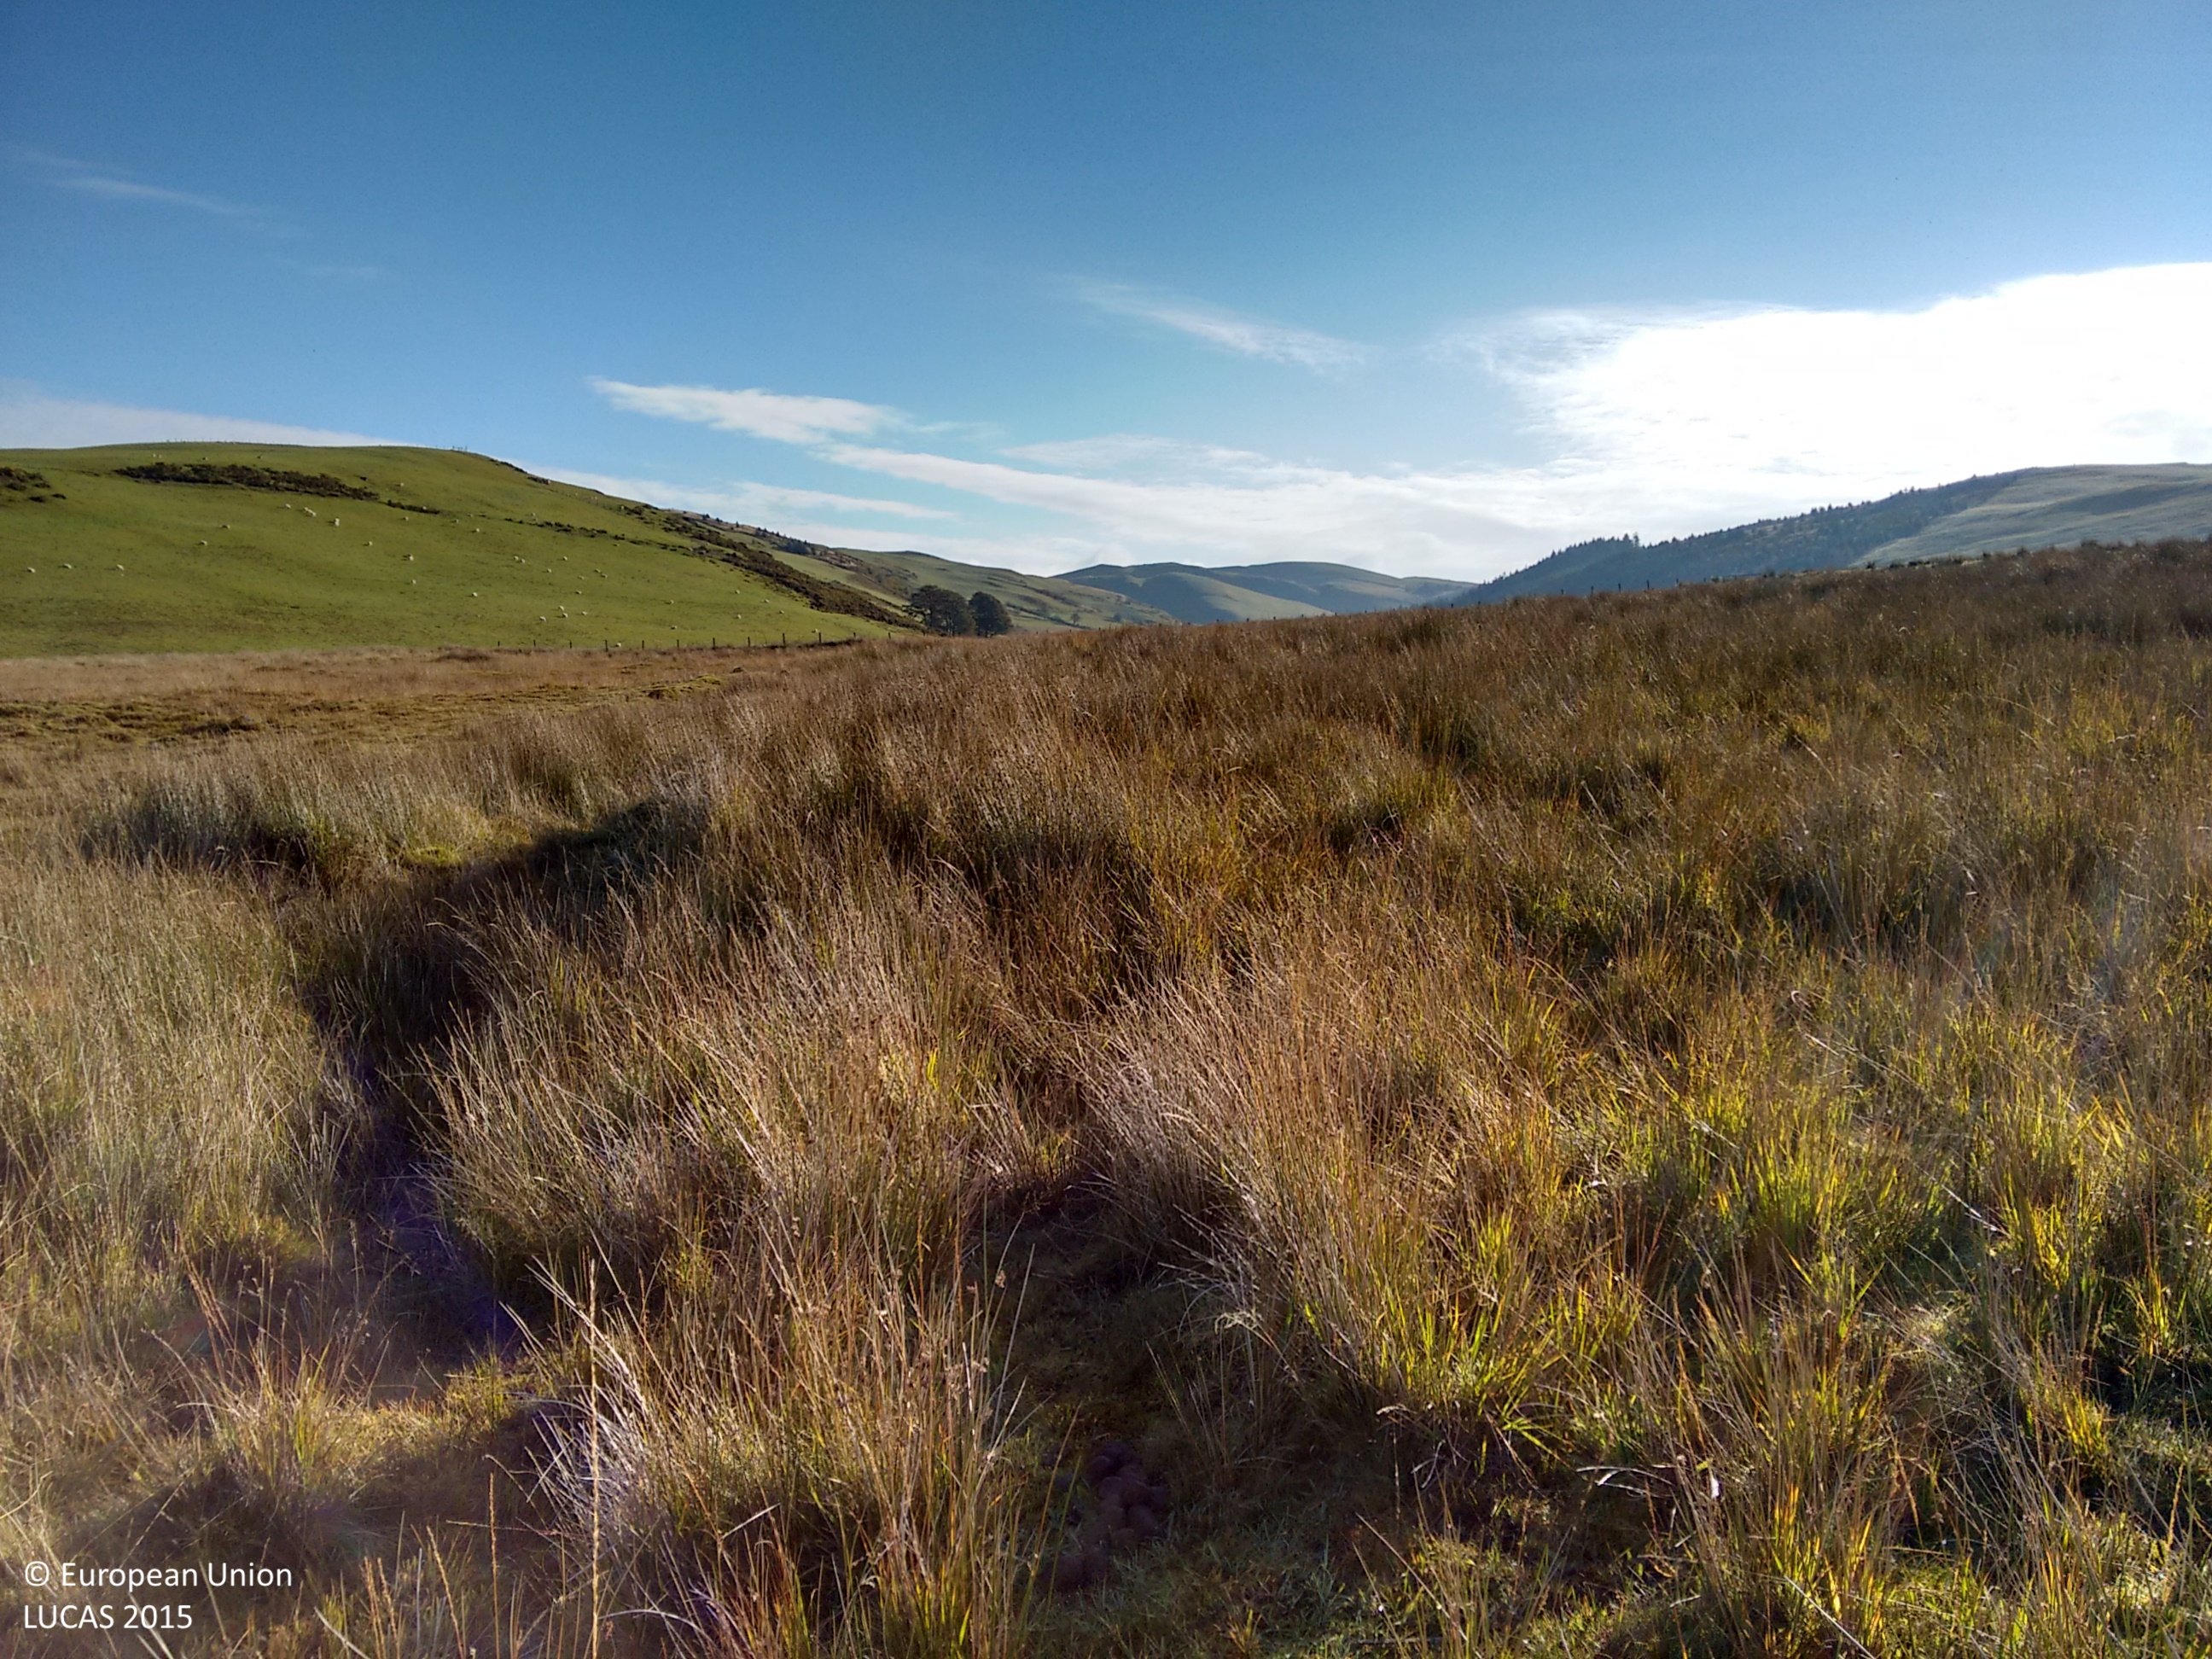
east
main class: Grassland
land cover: Grassland without tree/shrub cover
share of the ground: > 75 %
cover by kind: herbaceous plants 100 %
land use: Agriculture (excluding fallow land and kitchen gardens)
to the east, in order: Grassland without tree/shrub cover; Fences; Grass margins; Ditches and canals; Grassland without tree/shrub cover; Ditches and canals; Grassland without tree/shrub cover
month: October
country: GB
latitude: 52.3633
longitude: -3.8515
